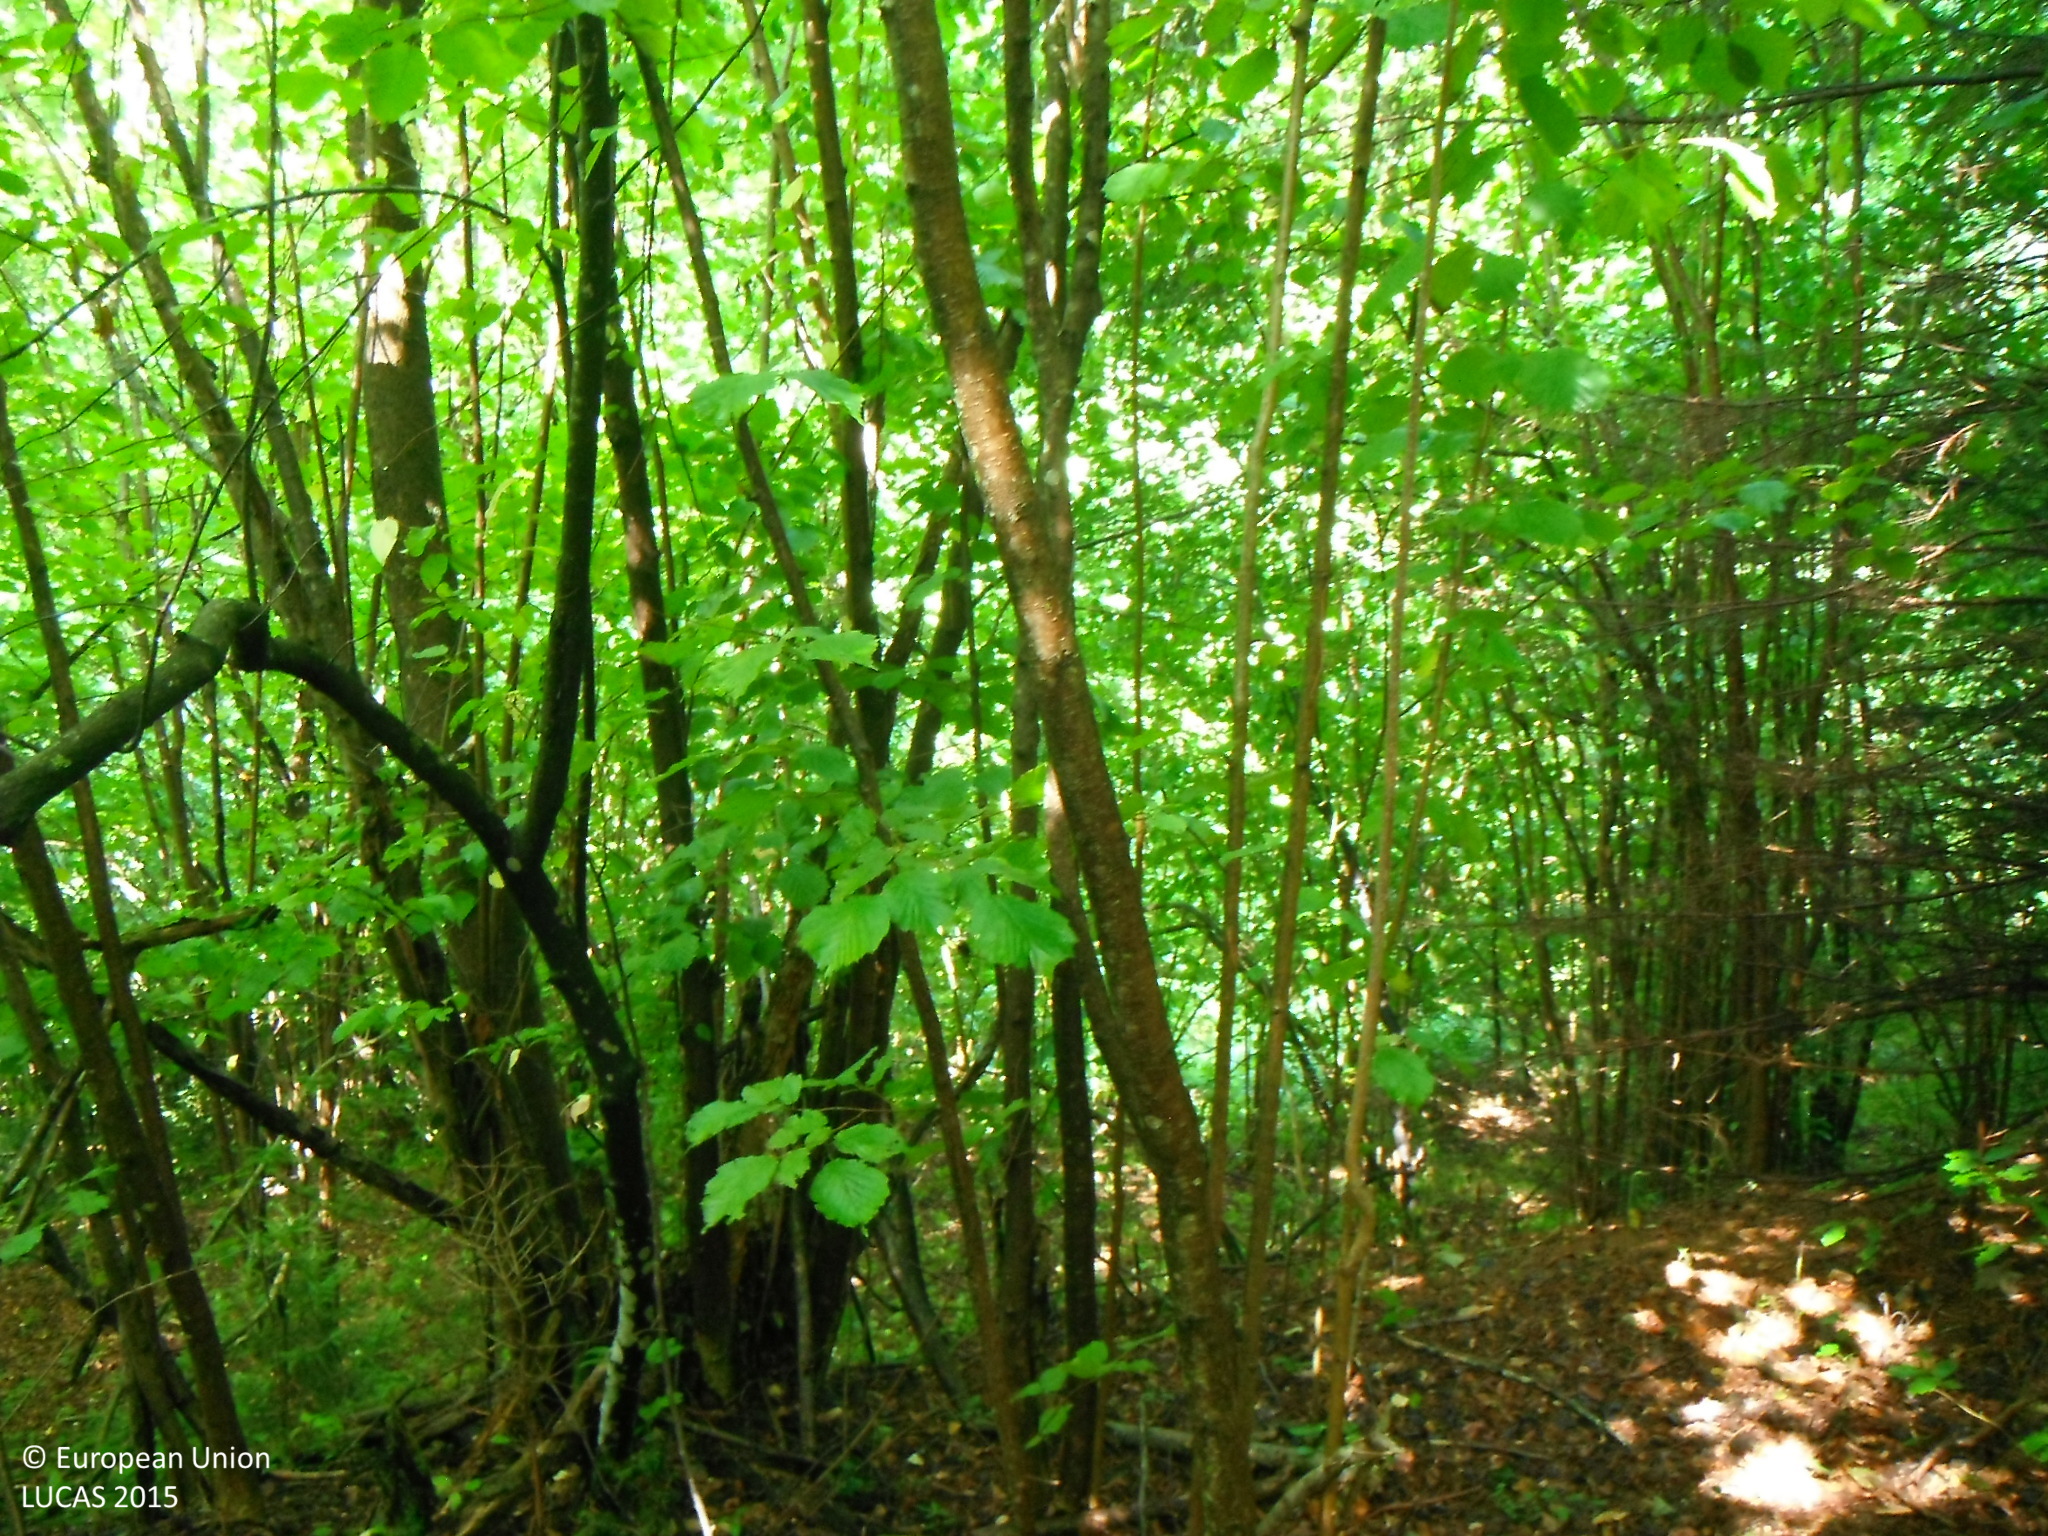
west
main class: Woodland
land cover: Broadleaved woodland
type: mesophytic deciduous forest
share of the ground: > 75 %
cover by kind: broadleaved forest trees 100 %
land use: Semi-natural and natural areas not in use
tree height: > 5 m
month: July
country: SK
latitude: 48.8538
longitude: 19.6078
